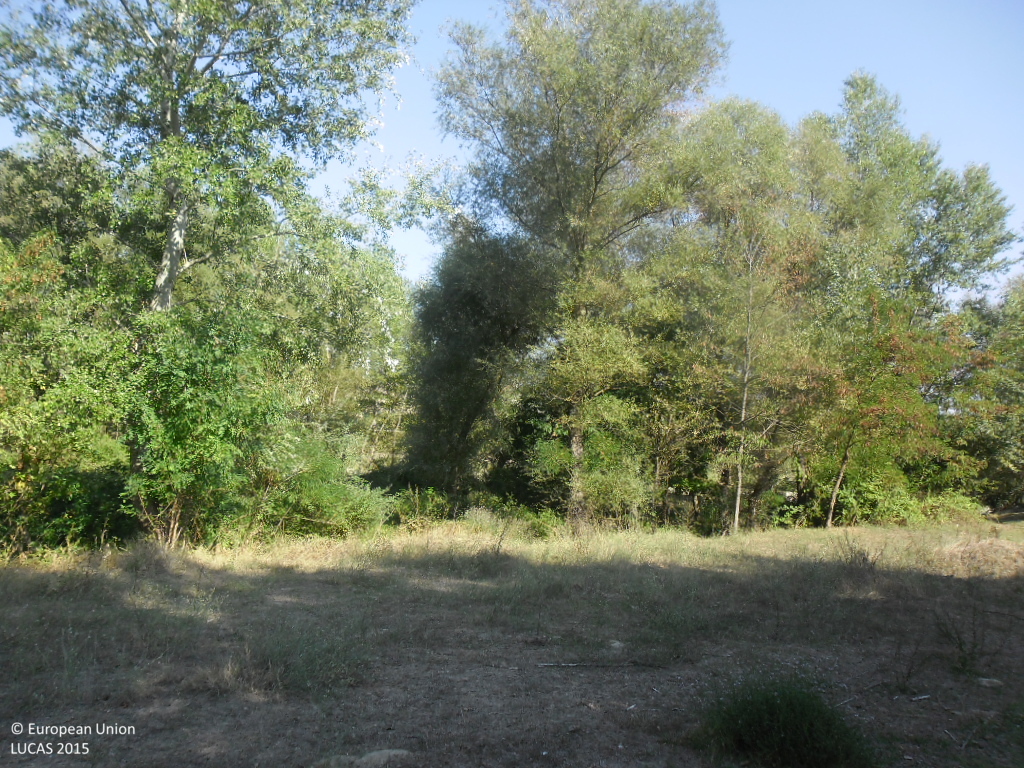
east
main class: Woodland
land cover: Broadleaved woodland
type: mesophytic deciduous forest
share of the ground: > 75 %
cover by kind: broadleaved forest trees 95 %, shrubs 5 %
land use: Forestry
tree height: < 5 m
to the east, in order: Broadleaved woodland; Tracks; Grassland without tree/shrub cover; Broadleaved woodland; Inland fresh running water; Broadleaved woodland; Rocks and stones; Inland fresh running water; Broadleaved woodland; Tracks; Broadleaved woodland
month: September
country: BG
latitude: 41.6199
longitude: 23.2113
